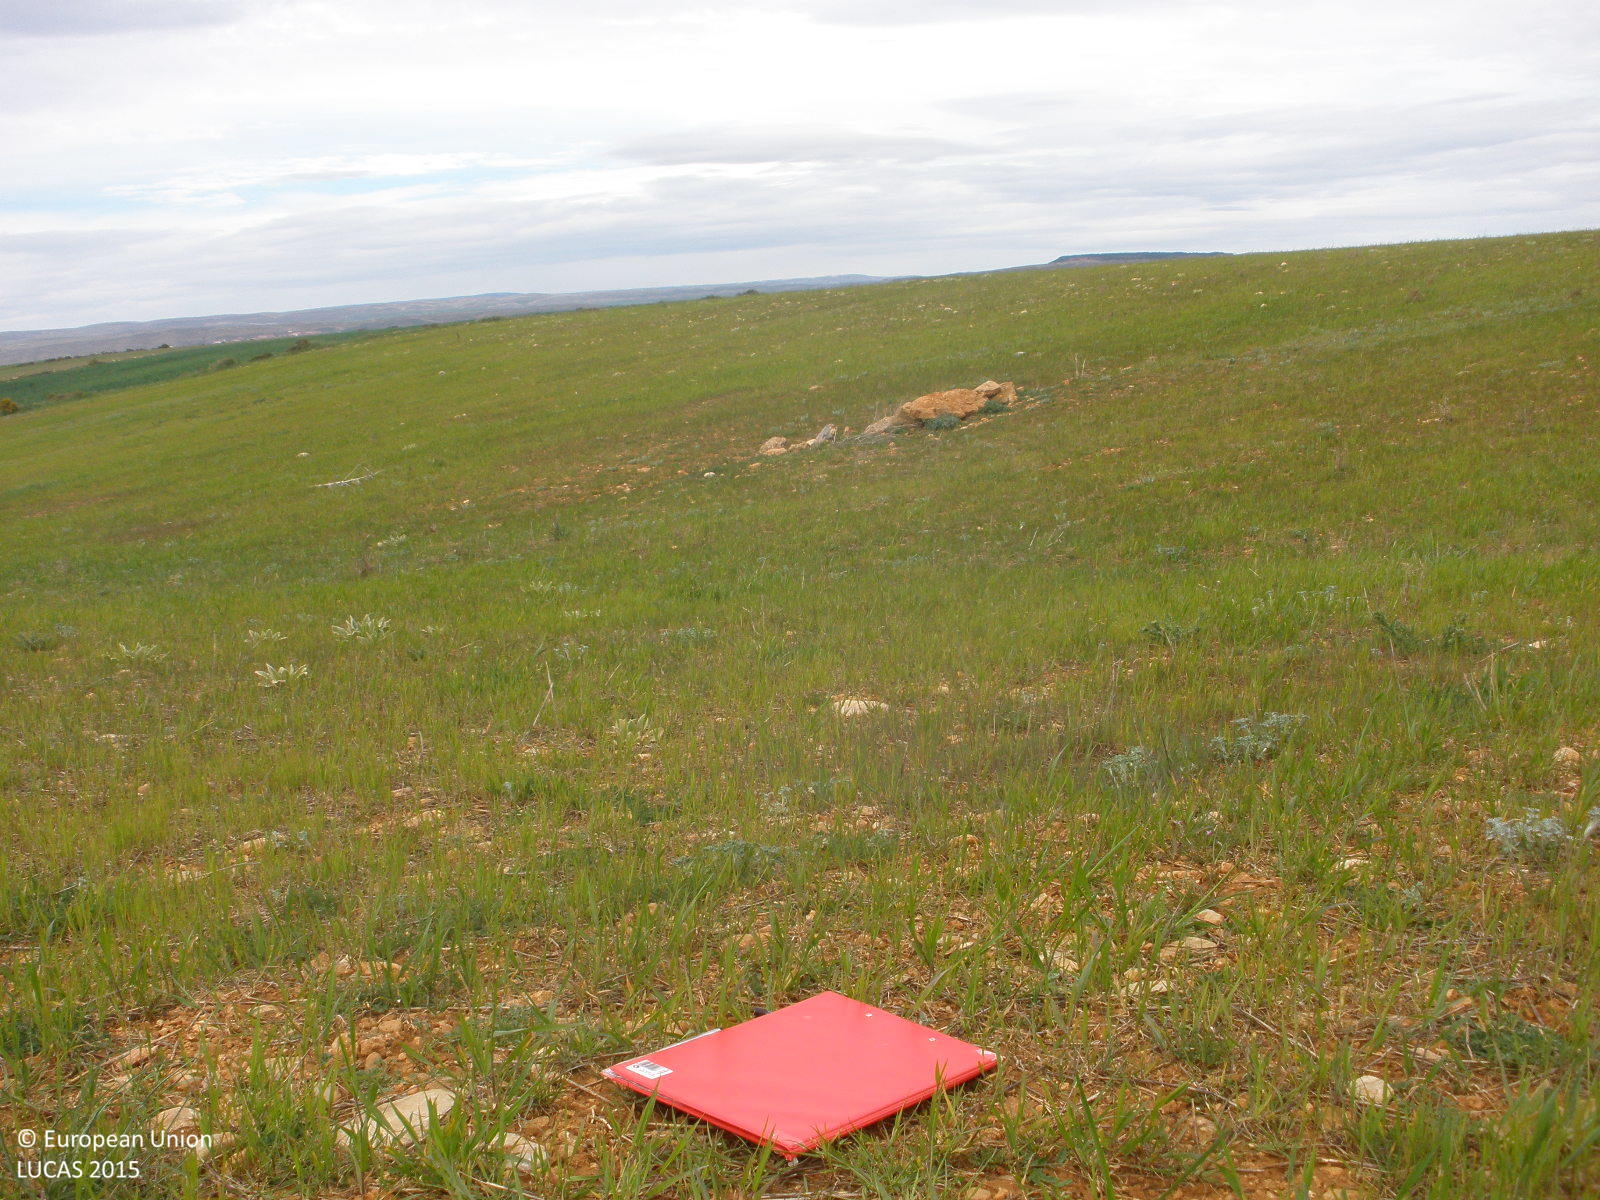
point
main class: Grassland
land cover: Spontaneously vegetated surfaces
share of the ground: > 75 %
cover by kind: herbaceous plants 80 %, consolidated bare surface 20 %
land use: Agriculture (excluding fallow land and kitchen gardens)
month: May
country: ES
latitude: 40.5277
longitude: -0.7880
